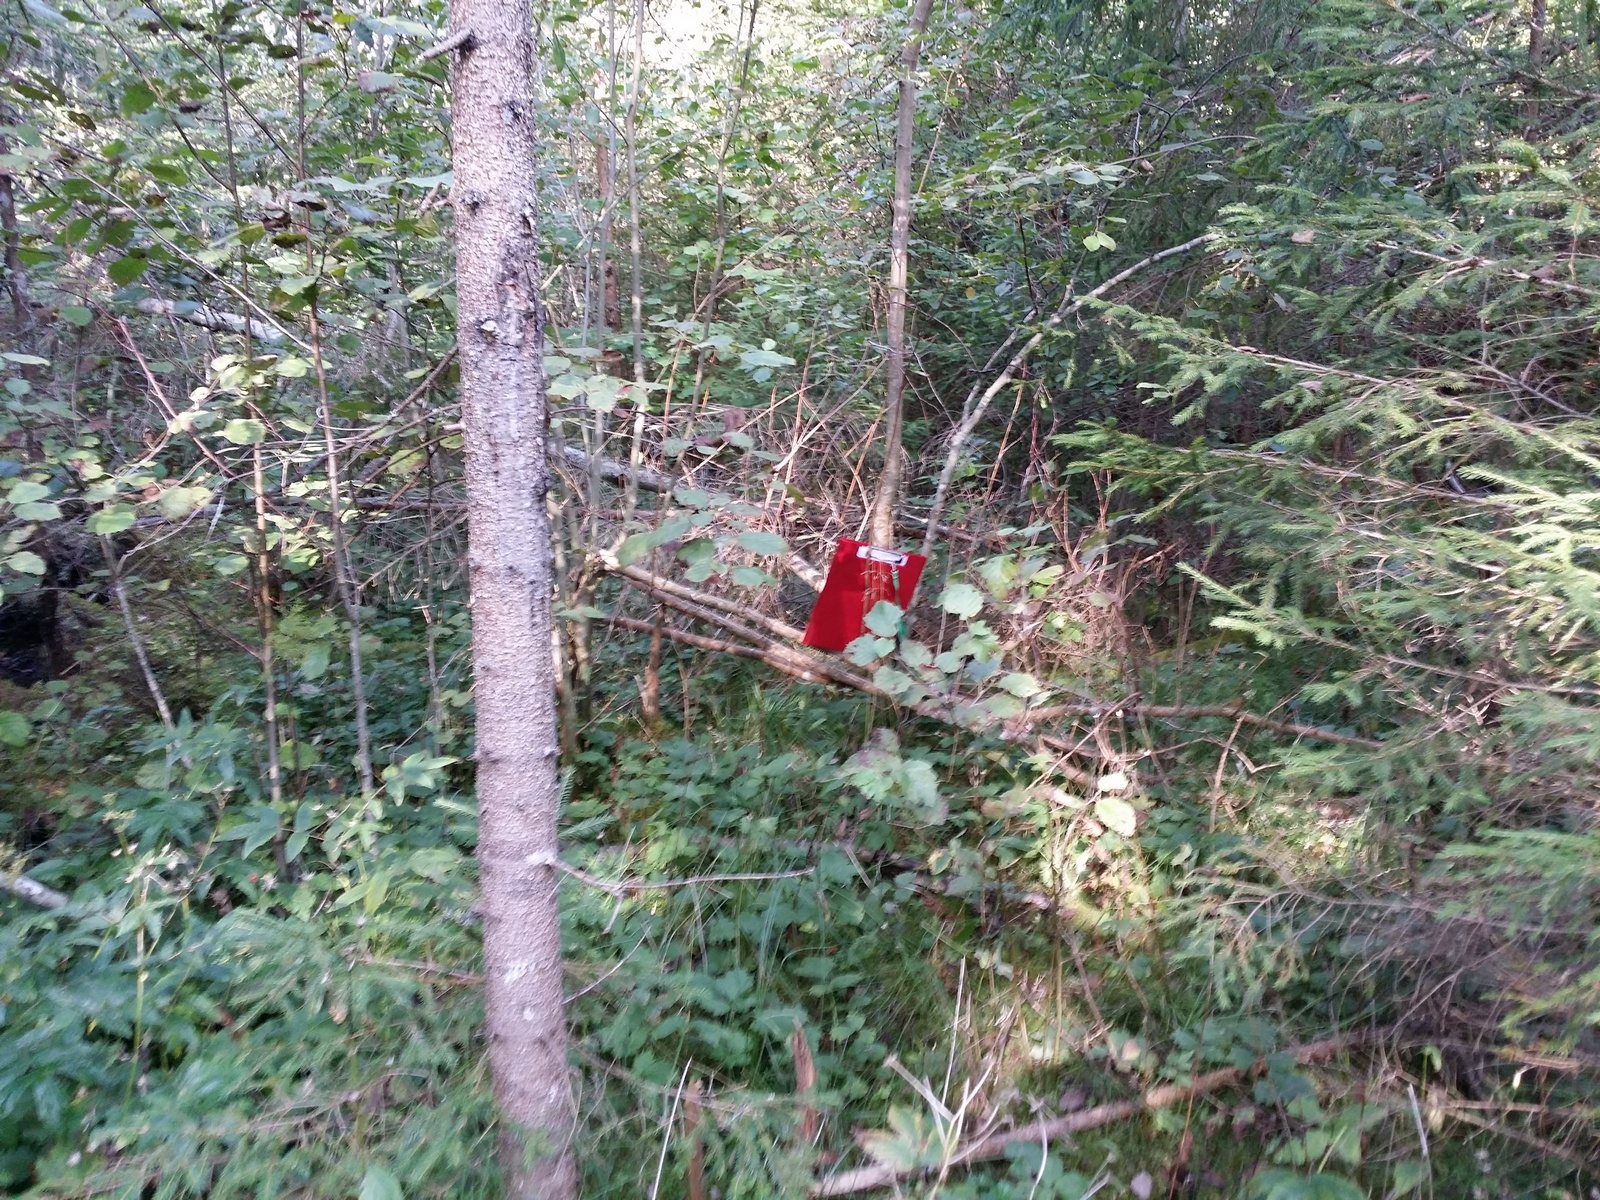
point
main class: Woodland
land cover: Spruce dominated mixed woodland
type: hemiboreal forest and nemoral coniferous forest and mixed broadleaved-coniferous forest
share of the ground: > 75 %
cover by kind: coniferous forest trees 50 %, broadleaved forest trees 35 %, shrubs 10 %, lichens and mosses 5 %
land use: Forestry
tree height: > 5 m
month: August
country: LV
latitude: 57.4369
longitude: 26.8623
